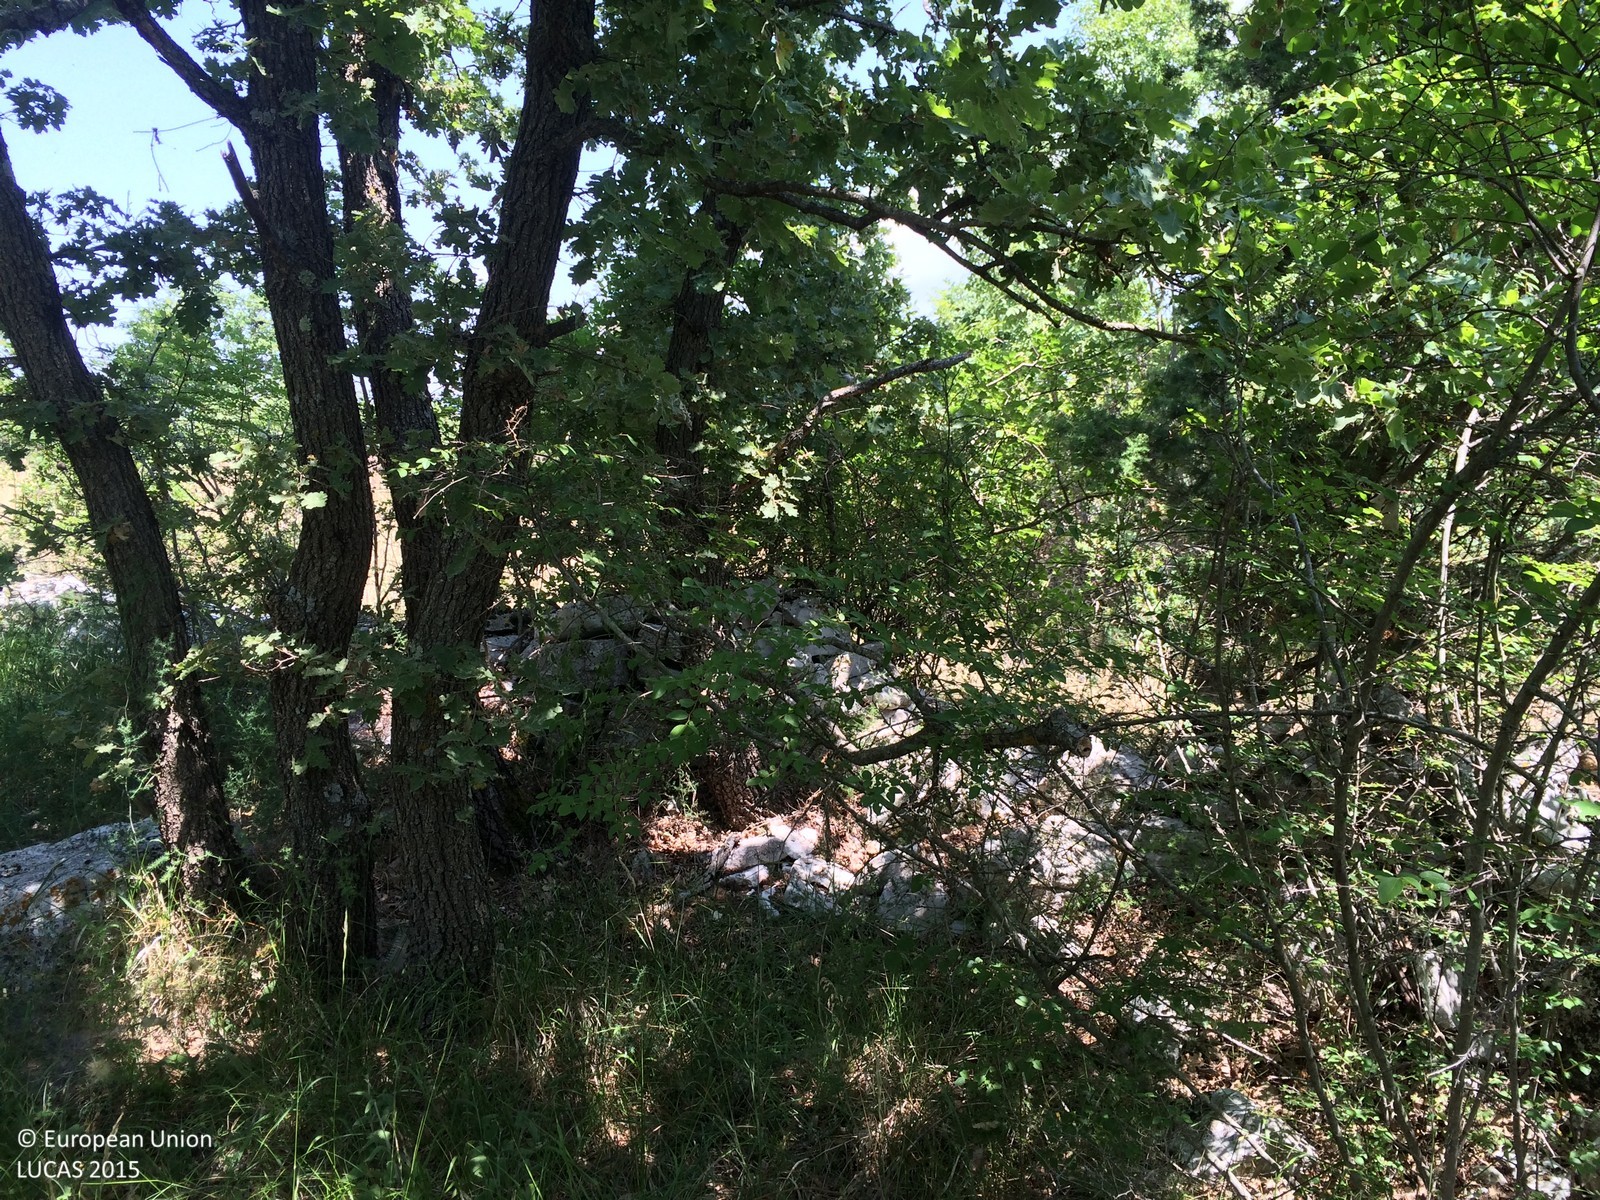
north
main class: Grassland
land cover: Grassland with sparse tree/shrub cover
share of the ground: 50 - 75 %
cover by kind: herbaceous plants 90 %, broadleaved forest trees 5 %, shrubs 5 %
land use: Semi-natural and natural areas not in use
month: June
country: HR
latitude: 45.0367
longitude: 13.8661
